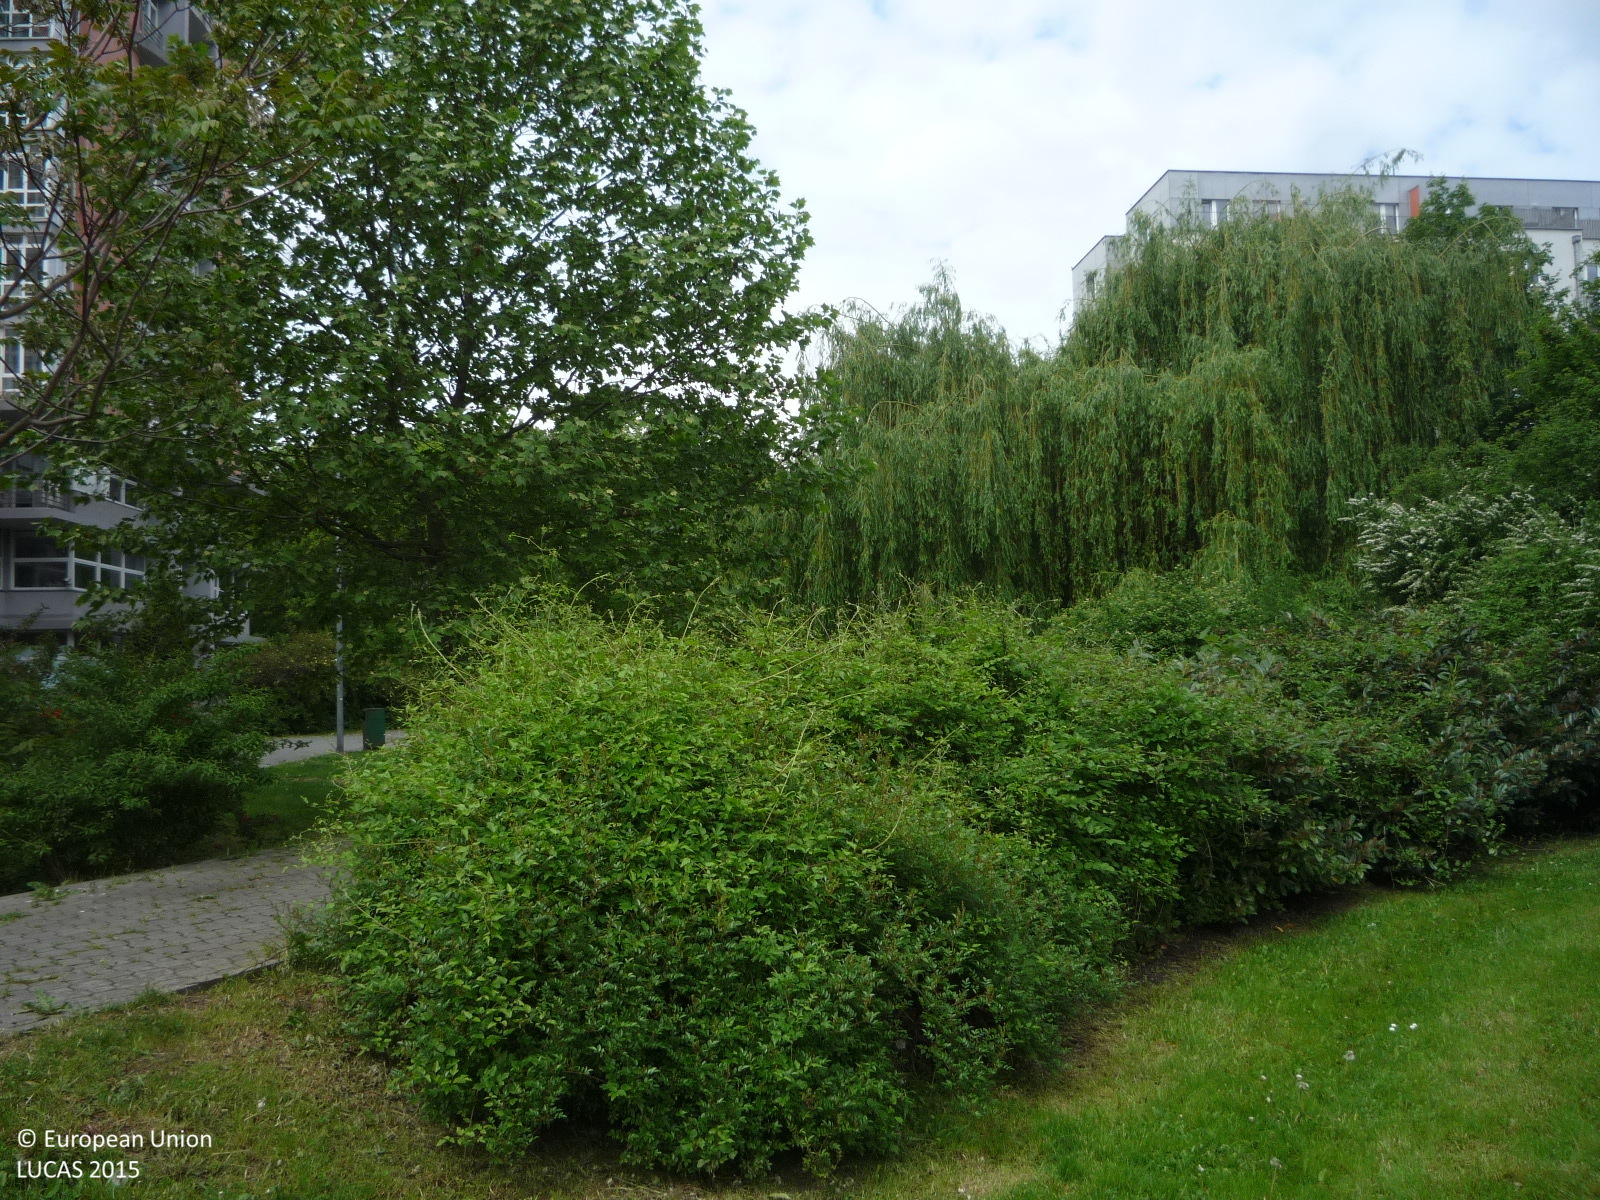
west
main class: Grassland
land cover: Grassland with sparse tree/shrub cover
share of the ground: > 75 %
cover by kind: herbaceous plants 90 %, broadleaved forest trees 5 %, shrubs 5 %
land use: Residential
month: May
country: CZ
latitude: 50.0780
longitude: 14.4873
